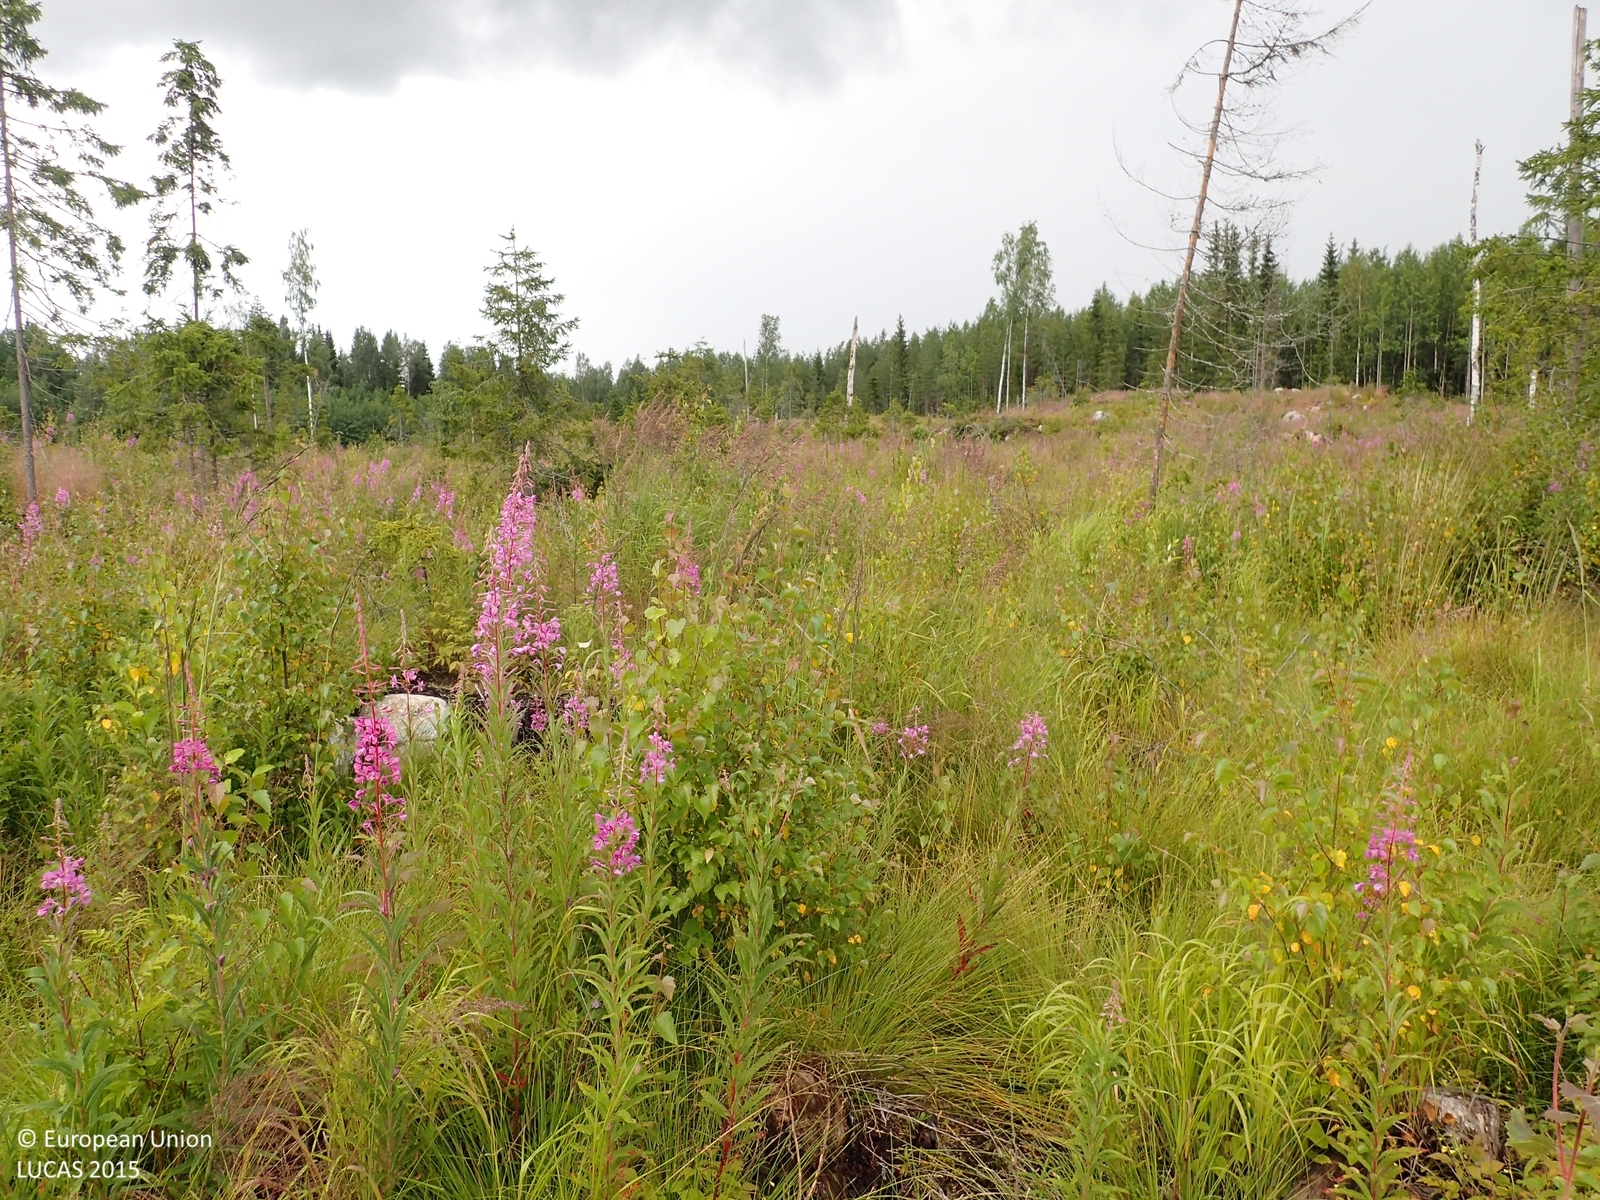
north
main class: Woodland
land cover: Spruce dominated mixed woodland
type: boreal forest
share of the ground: 10 - 25 %
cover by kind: herbaceous plants 85 %, broadleaved forest trees 10 %, coniferous forest trees 5 %
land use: Forestry
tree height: < 5 m
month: July
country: FI
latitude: 62.9839
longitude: 22.7433
